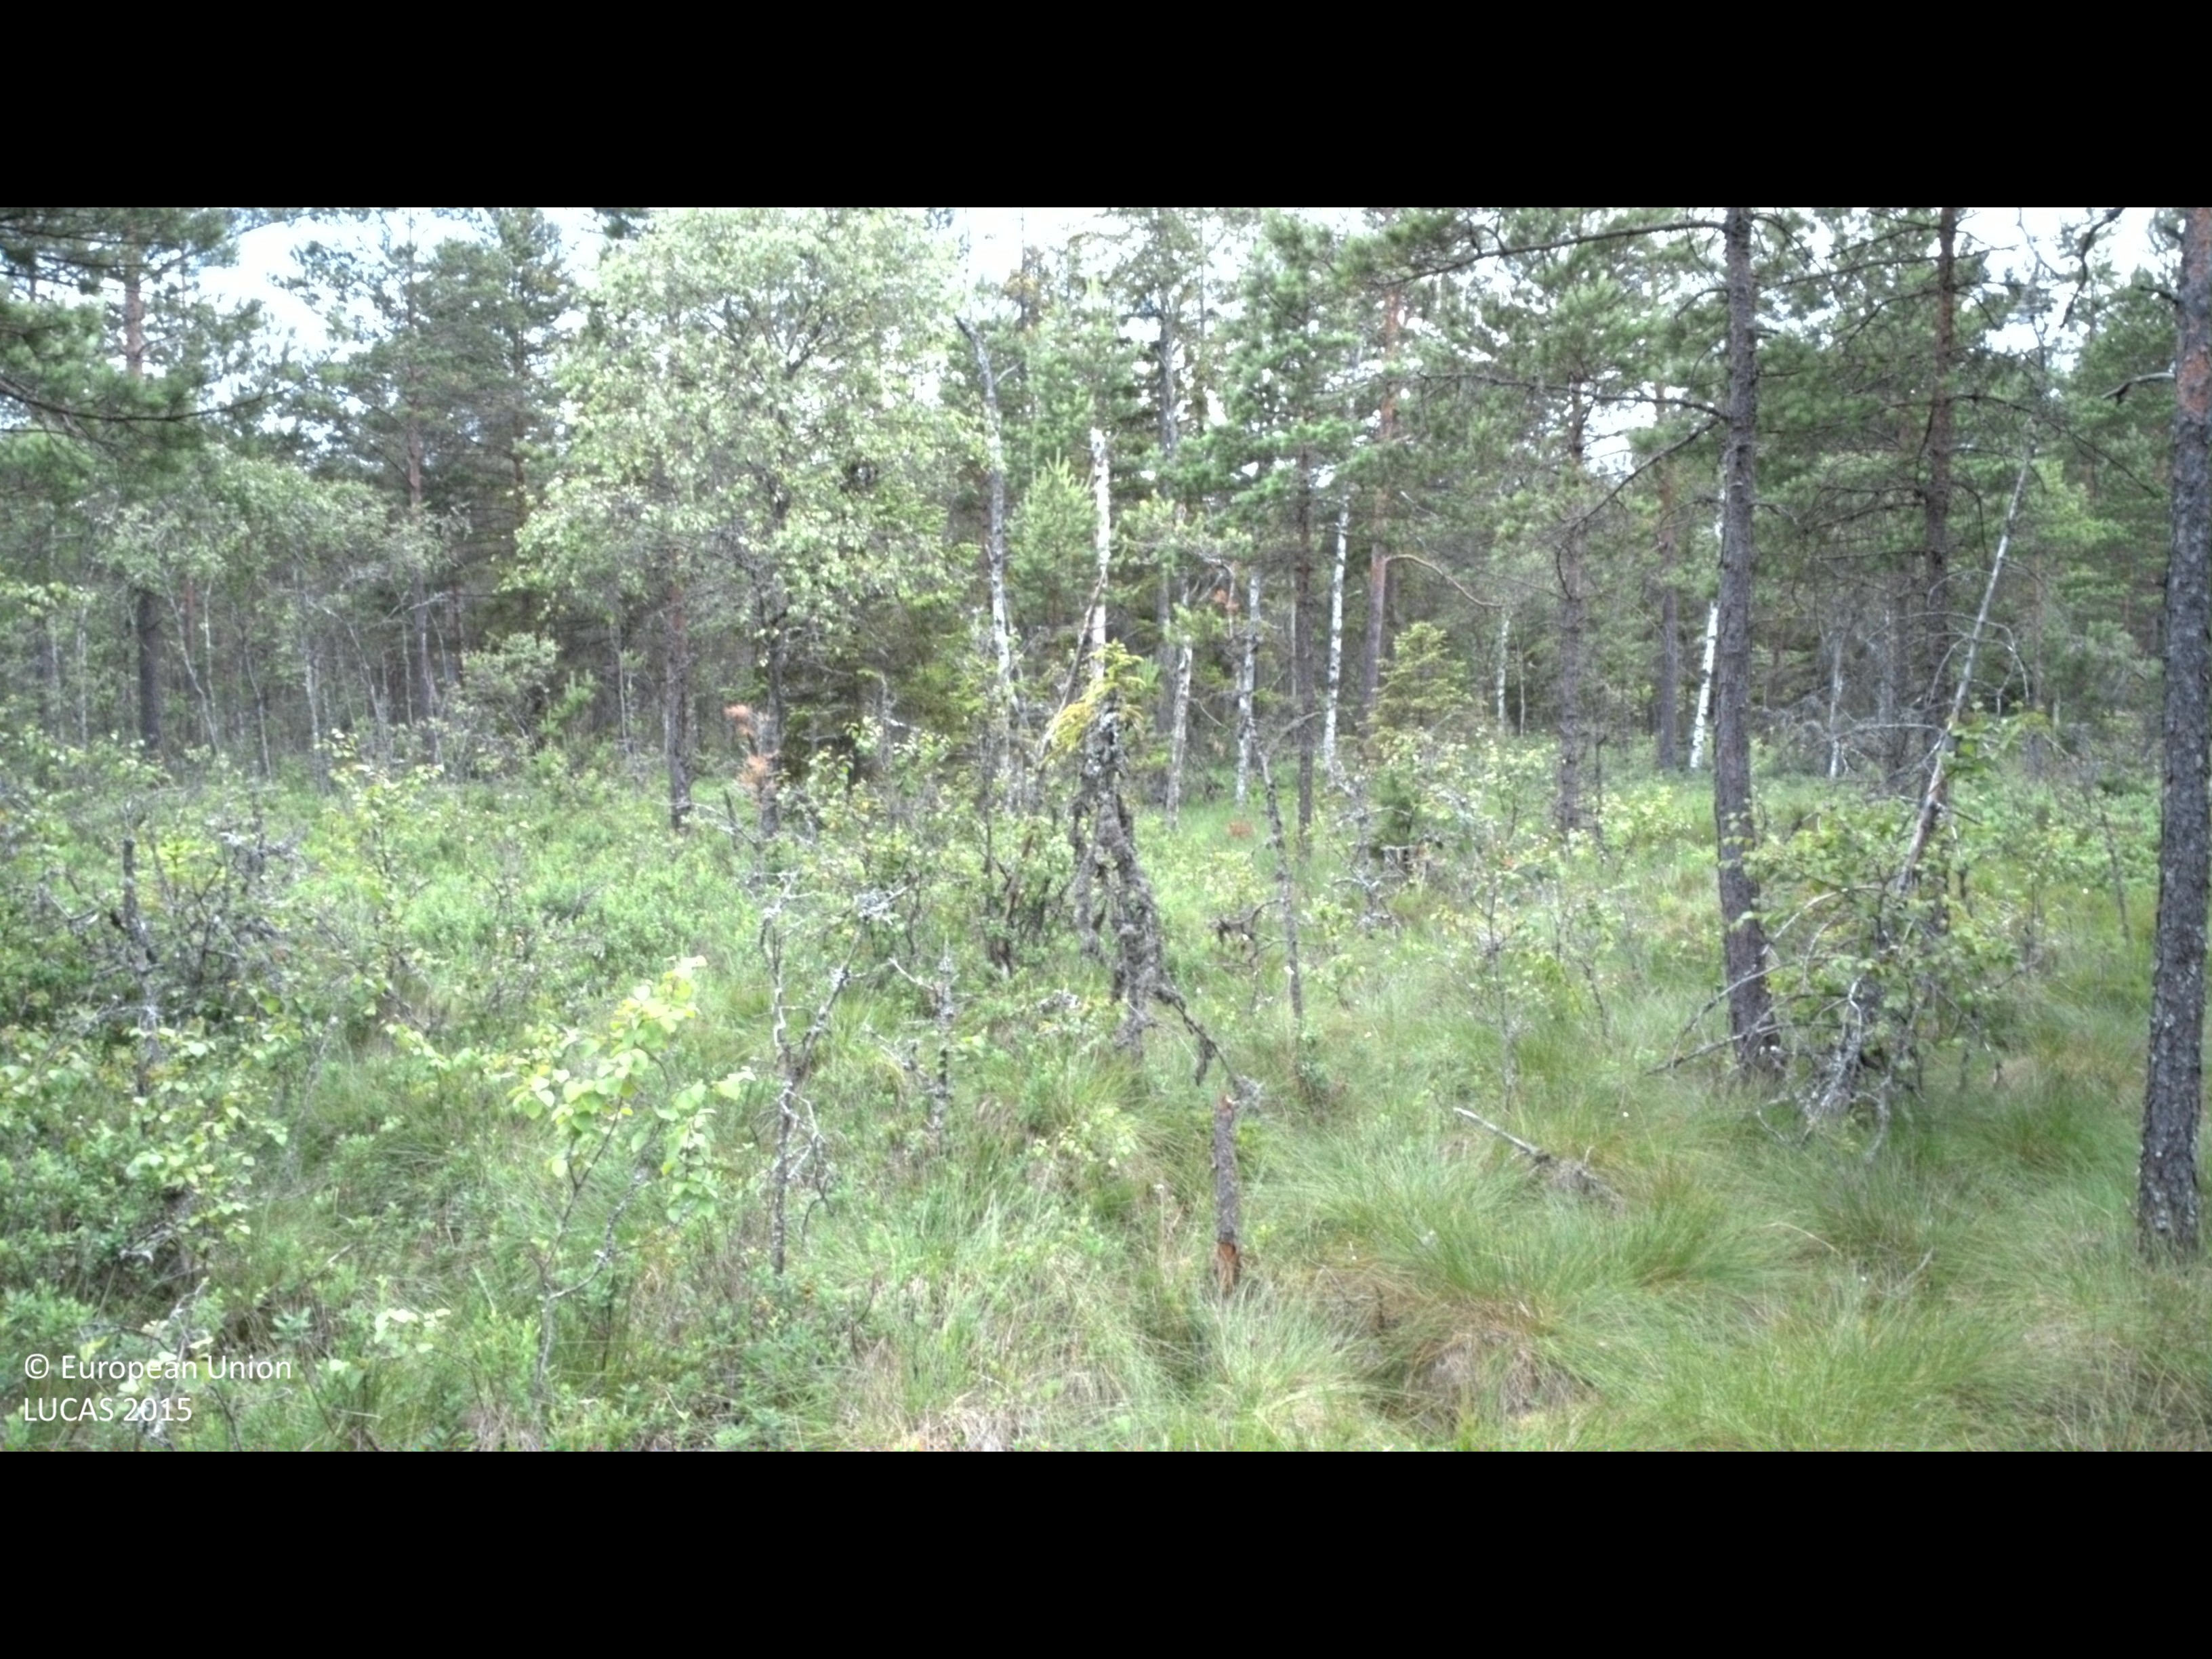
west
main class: Woodland
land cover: Pine dominated coniferous woodland
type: boreal forest
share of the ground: 25 - 50 %
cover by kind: coniferous forest trees 40 %, shrubs 30 %, herbaceous plants 15 %, lichens and mosses 10 %, broadleaved forest trees 5 %
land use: Forestry
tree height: > 5 m
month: July
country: SE
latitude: 56.5422
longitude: 14.4698
